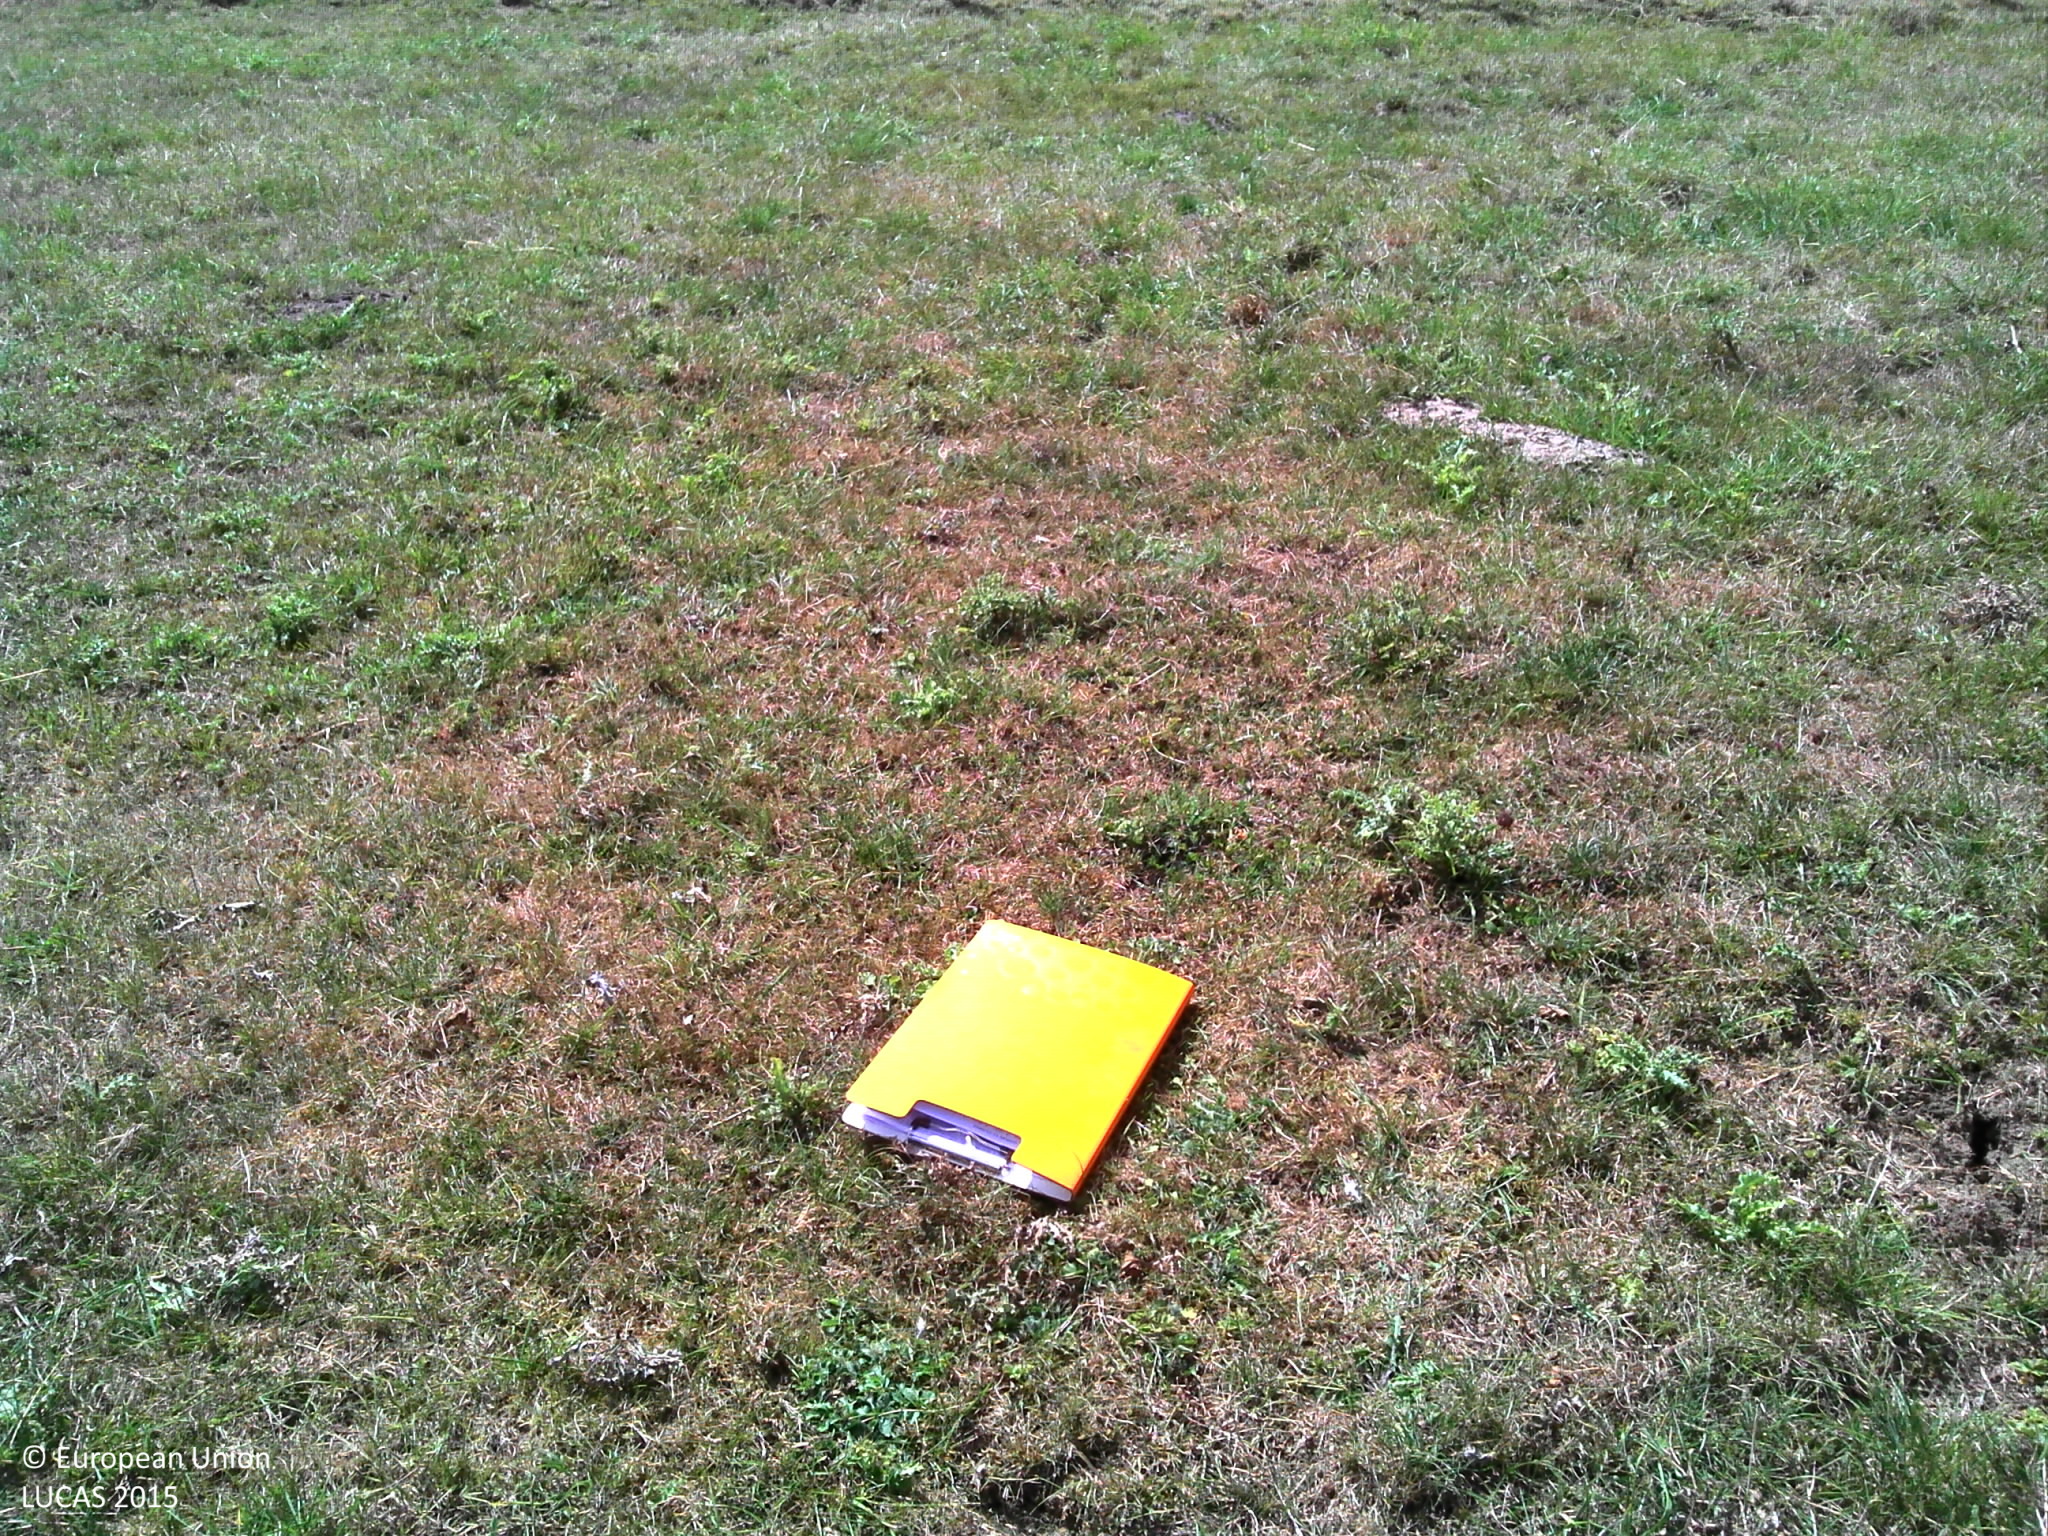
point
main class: Grassland
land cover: Grassland without tree/shrub cover
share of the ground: > 75 %
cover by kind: herbaceous plants 100 %
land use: Agriculture (excluding fallow land and kitchen gardens)
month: July
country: FR
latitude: 47.7792
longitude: 5.2622
